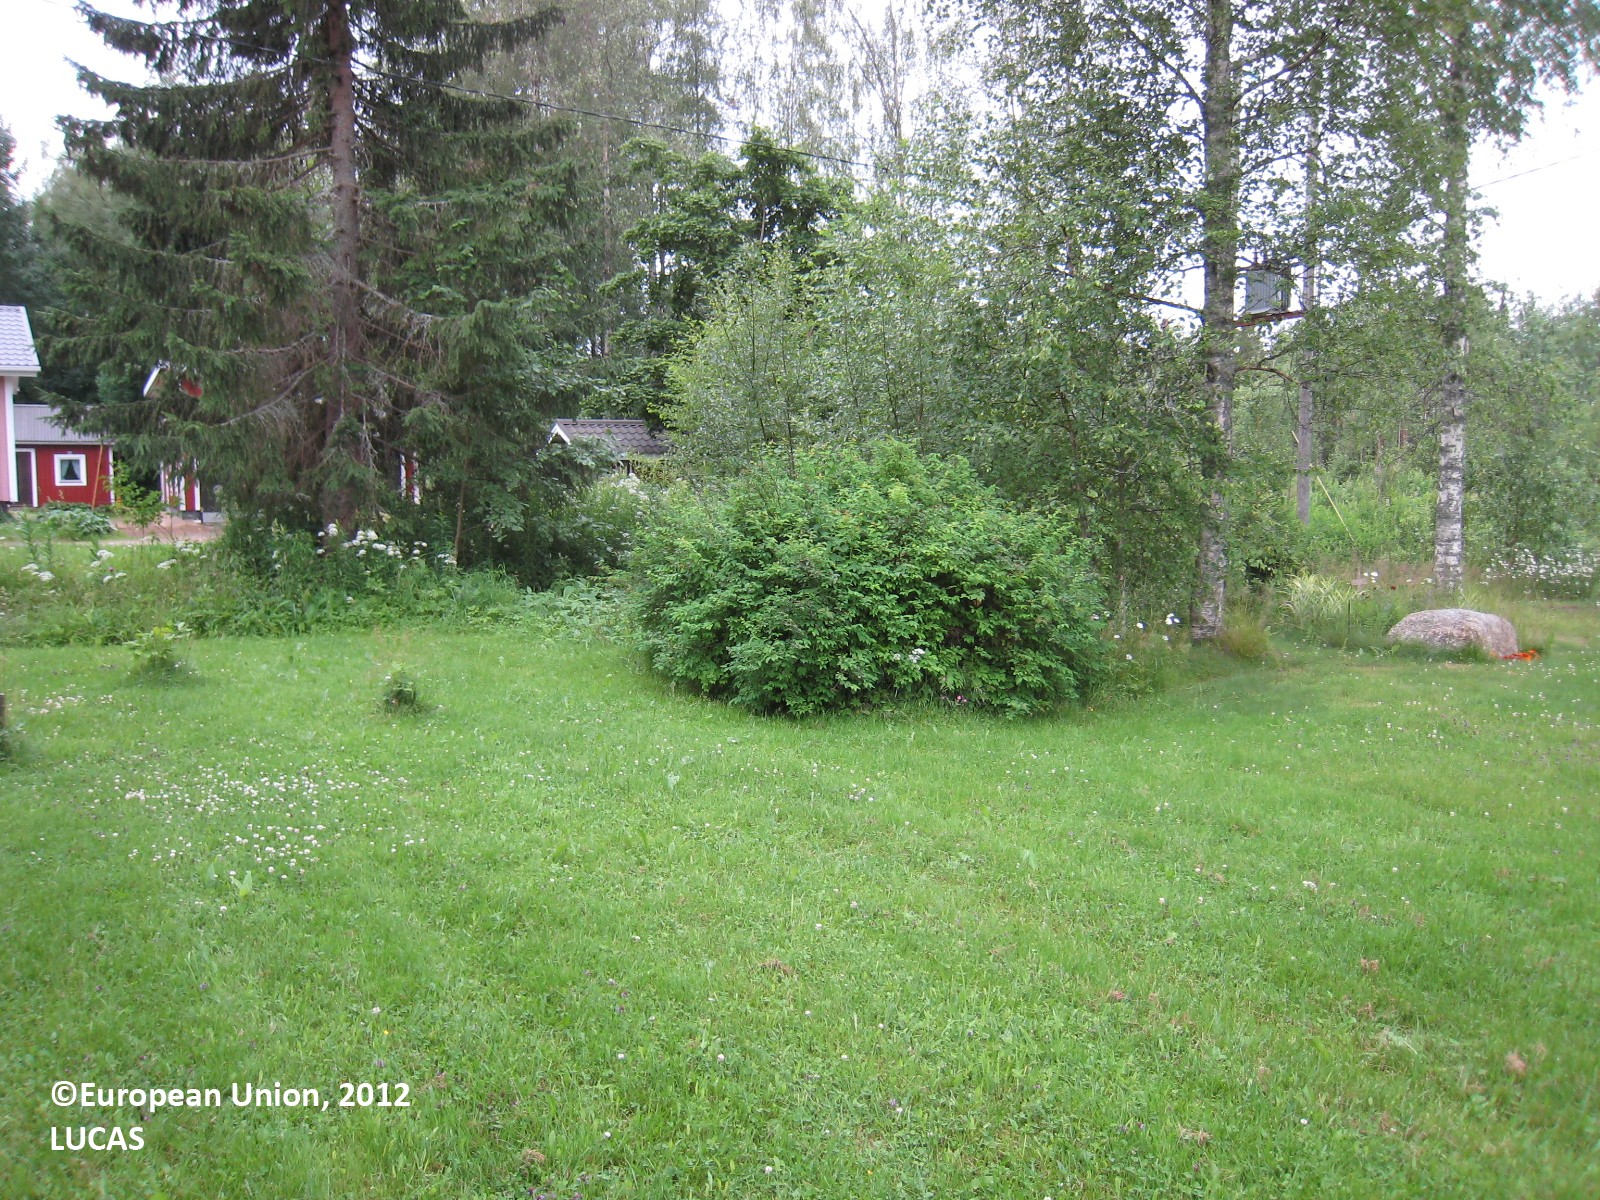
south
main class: Grassland
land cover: Grassland with sparse tree/shrub cover
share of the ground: > 75 %
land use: Residential
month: July
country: FI
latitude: 61.8284
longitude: 27.3922
